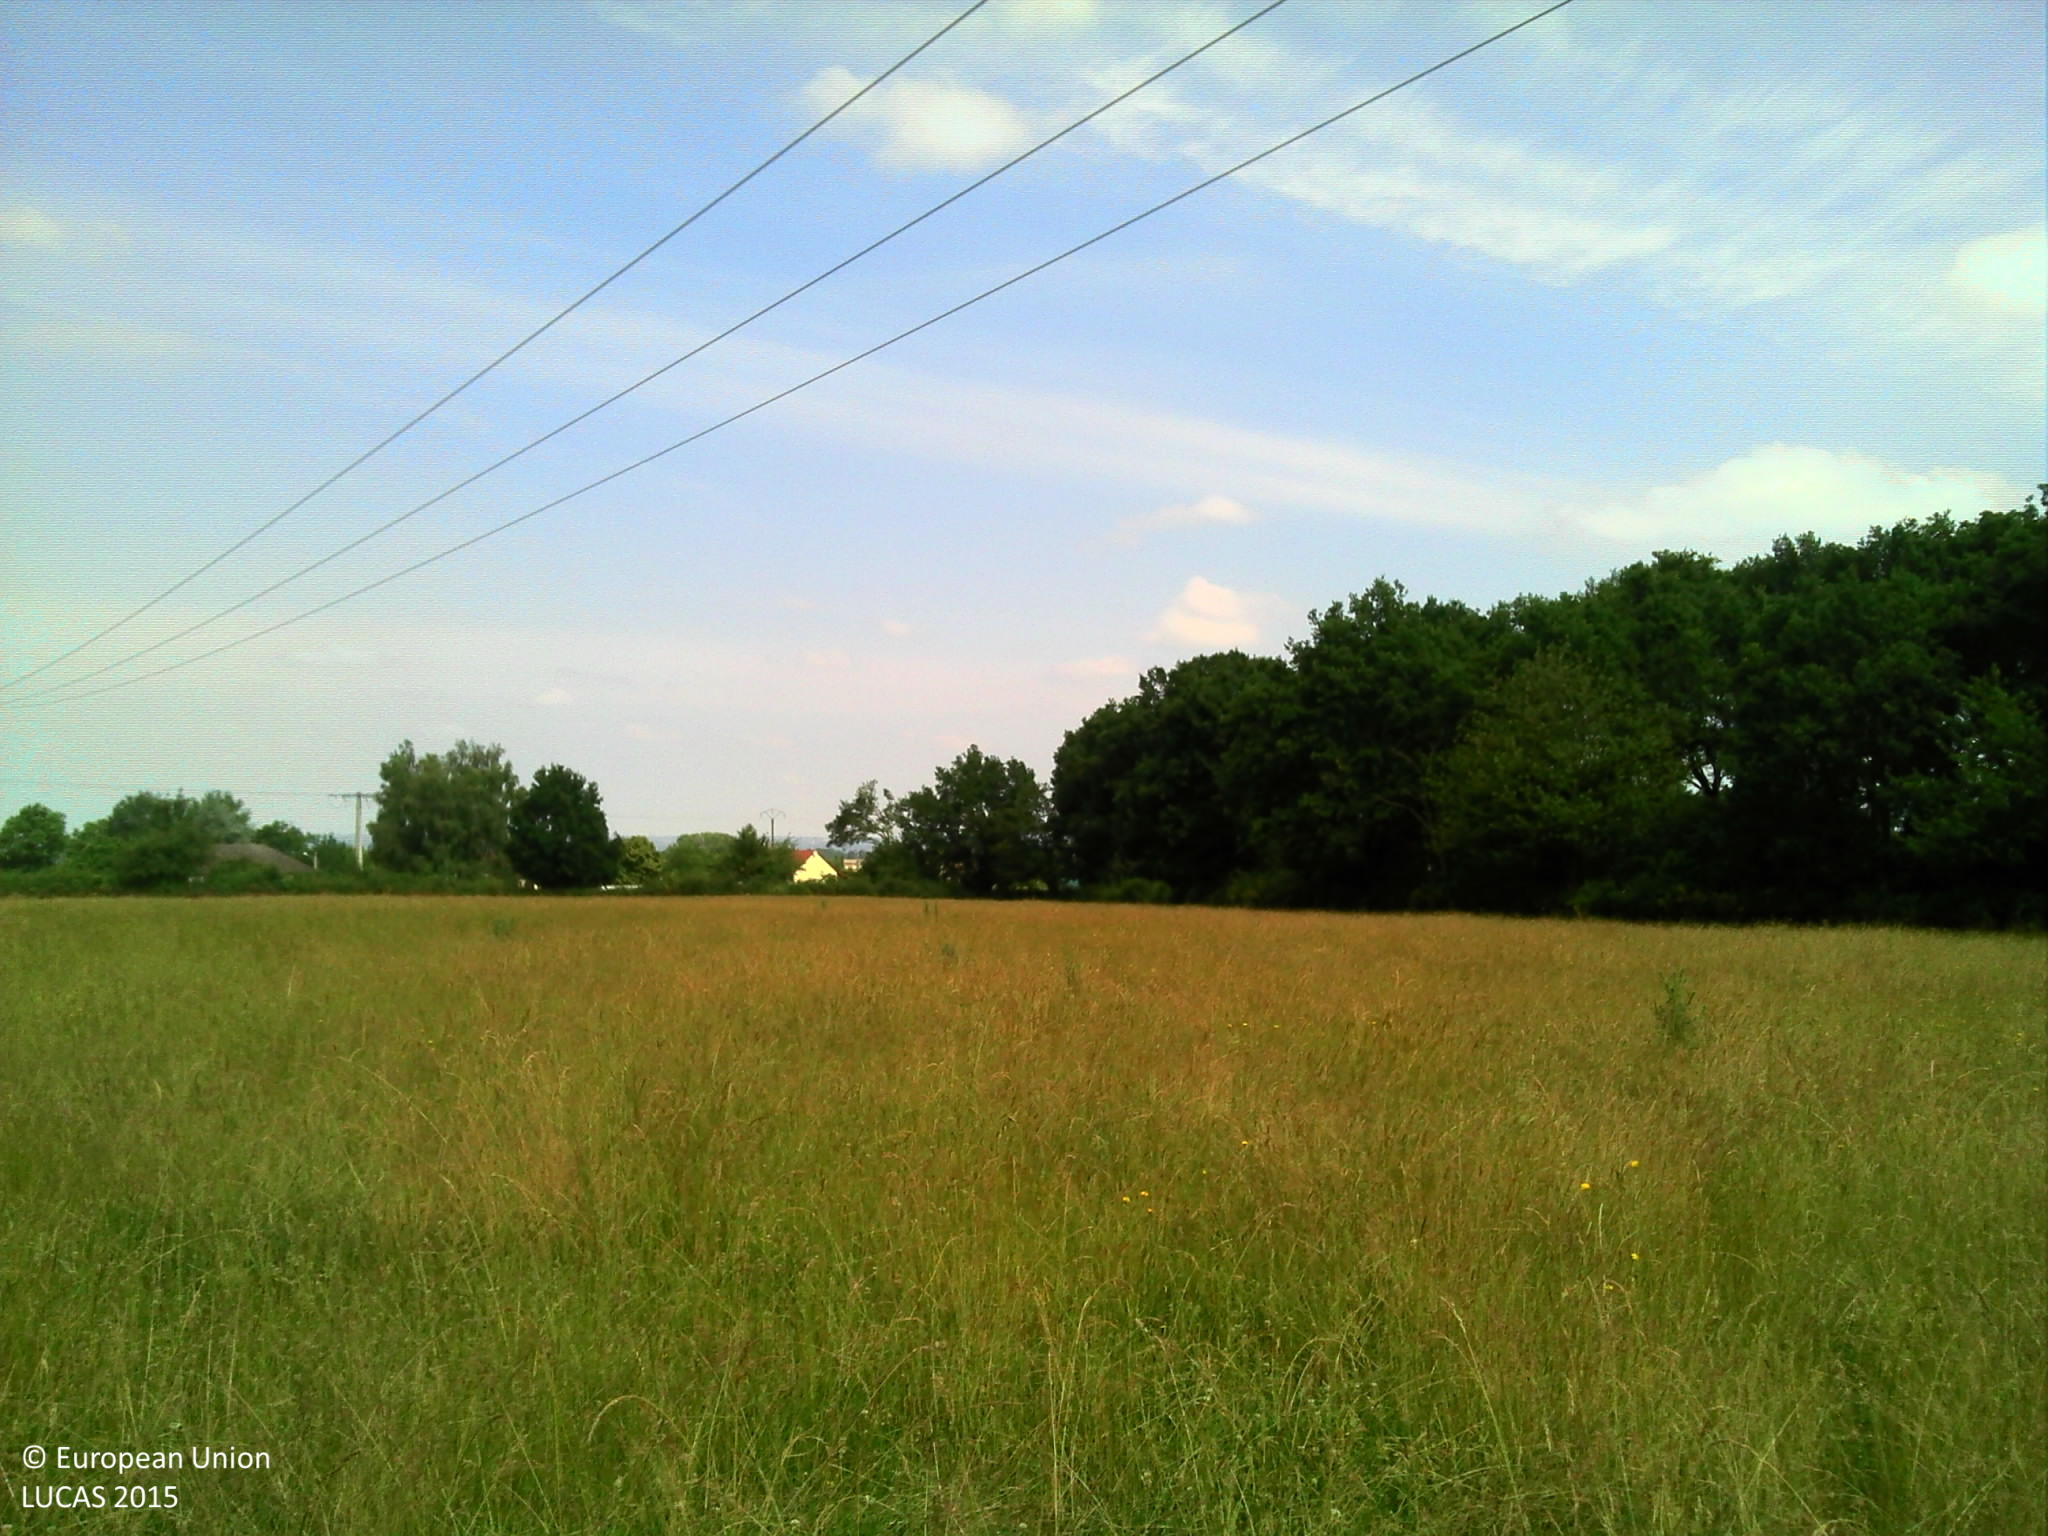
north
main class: Grassland
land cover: Grassland without tree/shrub cover
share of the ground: > 75 %
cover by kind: herbaceous plants 100 %
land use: Agriculture (excluding fallow land and kitchen gardens)
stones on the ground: < 10 %
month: June
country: FR
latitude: 46.3835
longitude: 2.8586
